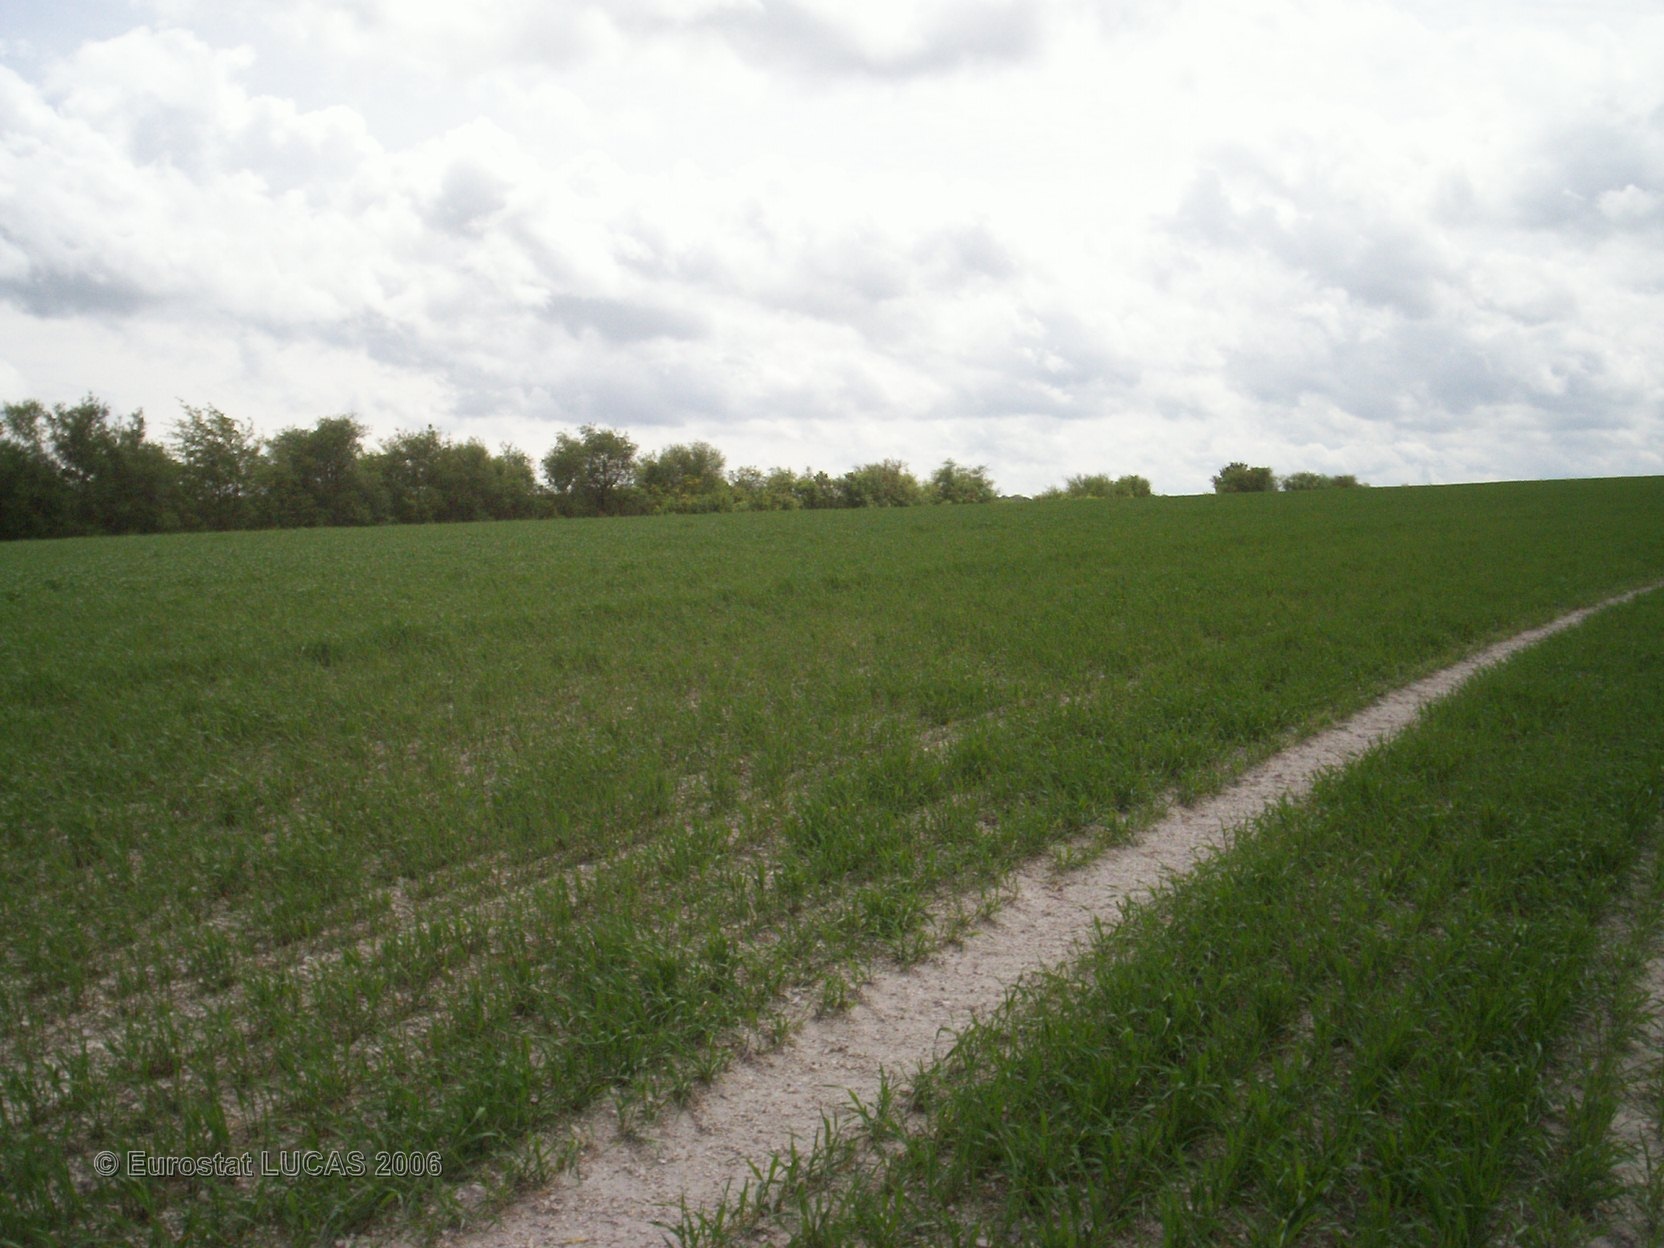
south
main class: Cropland
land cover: Barley
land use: Agriculture (excluding fallow land and kitchen gardens)
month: May
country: FR
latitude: 49.4853
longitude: 4.3501
